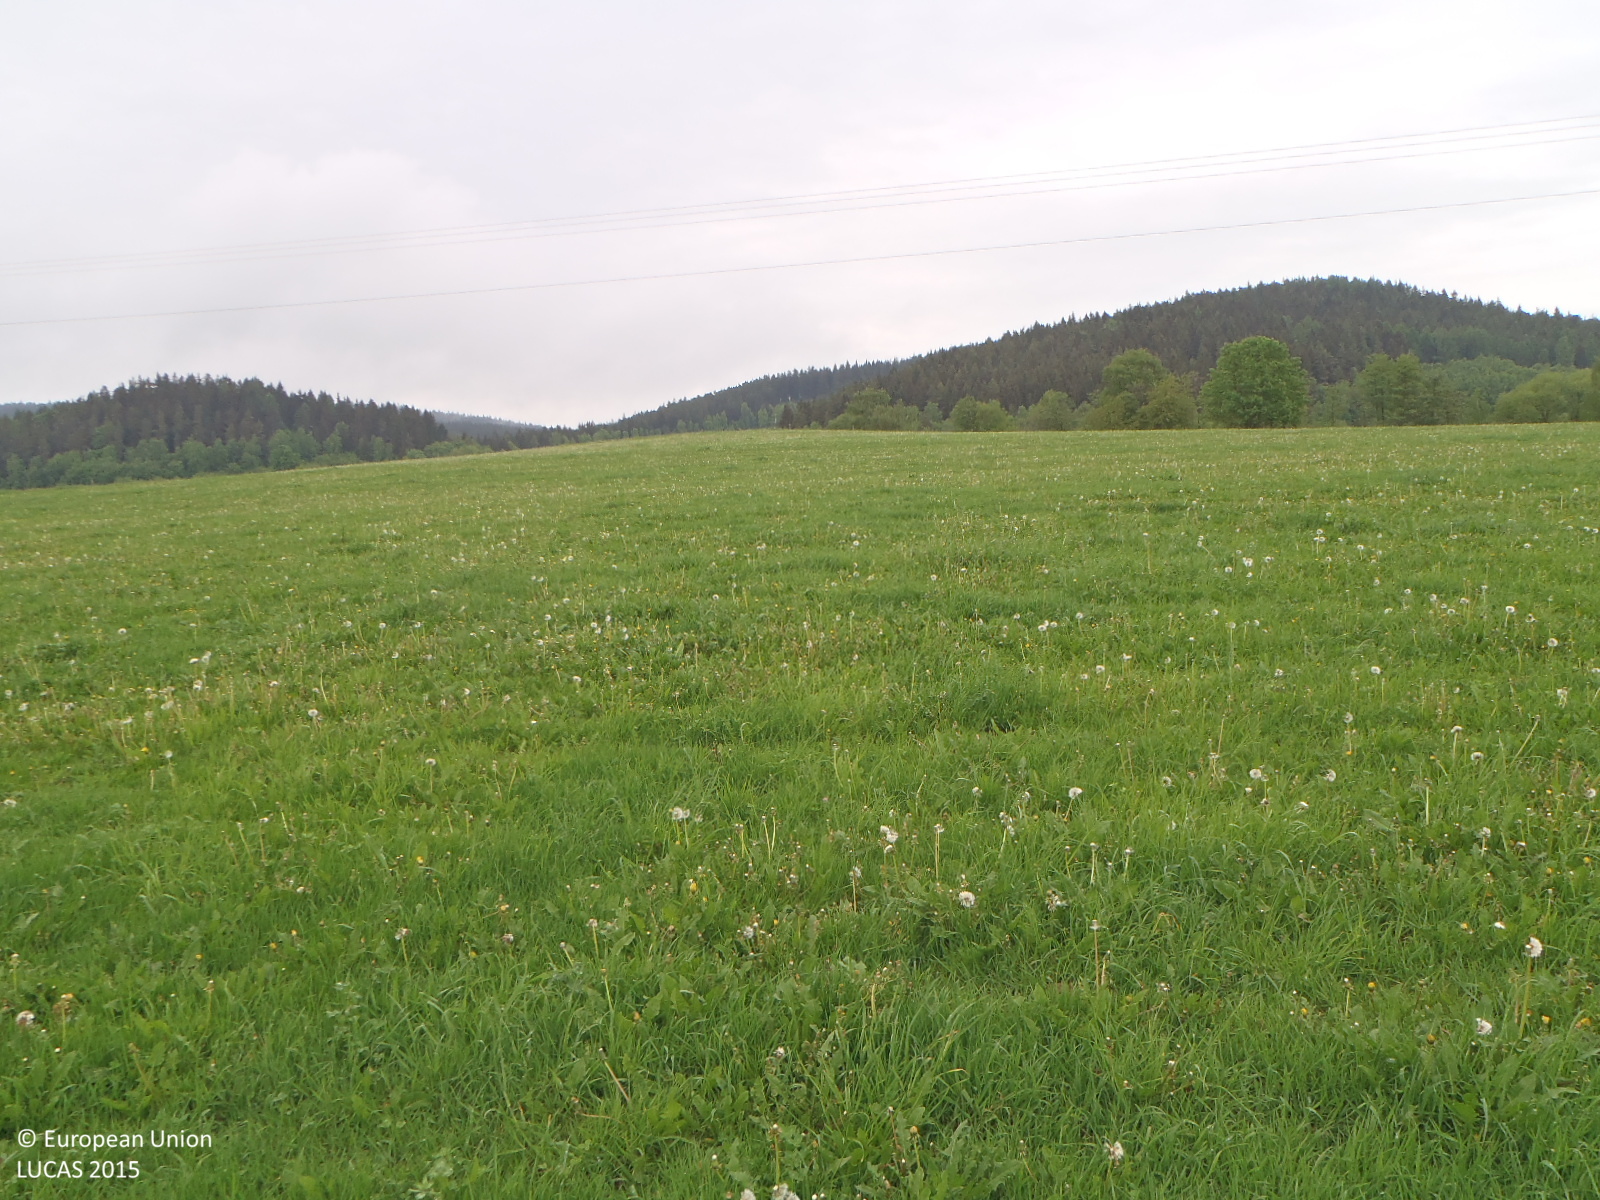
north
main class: Grassland
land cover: Grassland without tree/shrub cover
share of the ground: > 75 %
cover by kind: herbaceous plants 95 %, unconsolidated bare surface 5 %
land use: Agriculture (excluding fallow land and kitchen gardens)
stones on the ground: < 10 %
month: May
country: CZ
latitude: 48.7296
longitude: 14.4192
